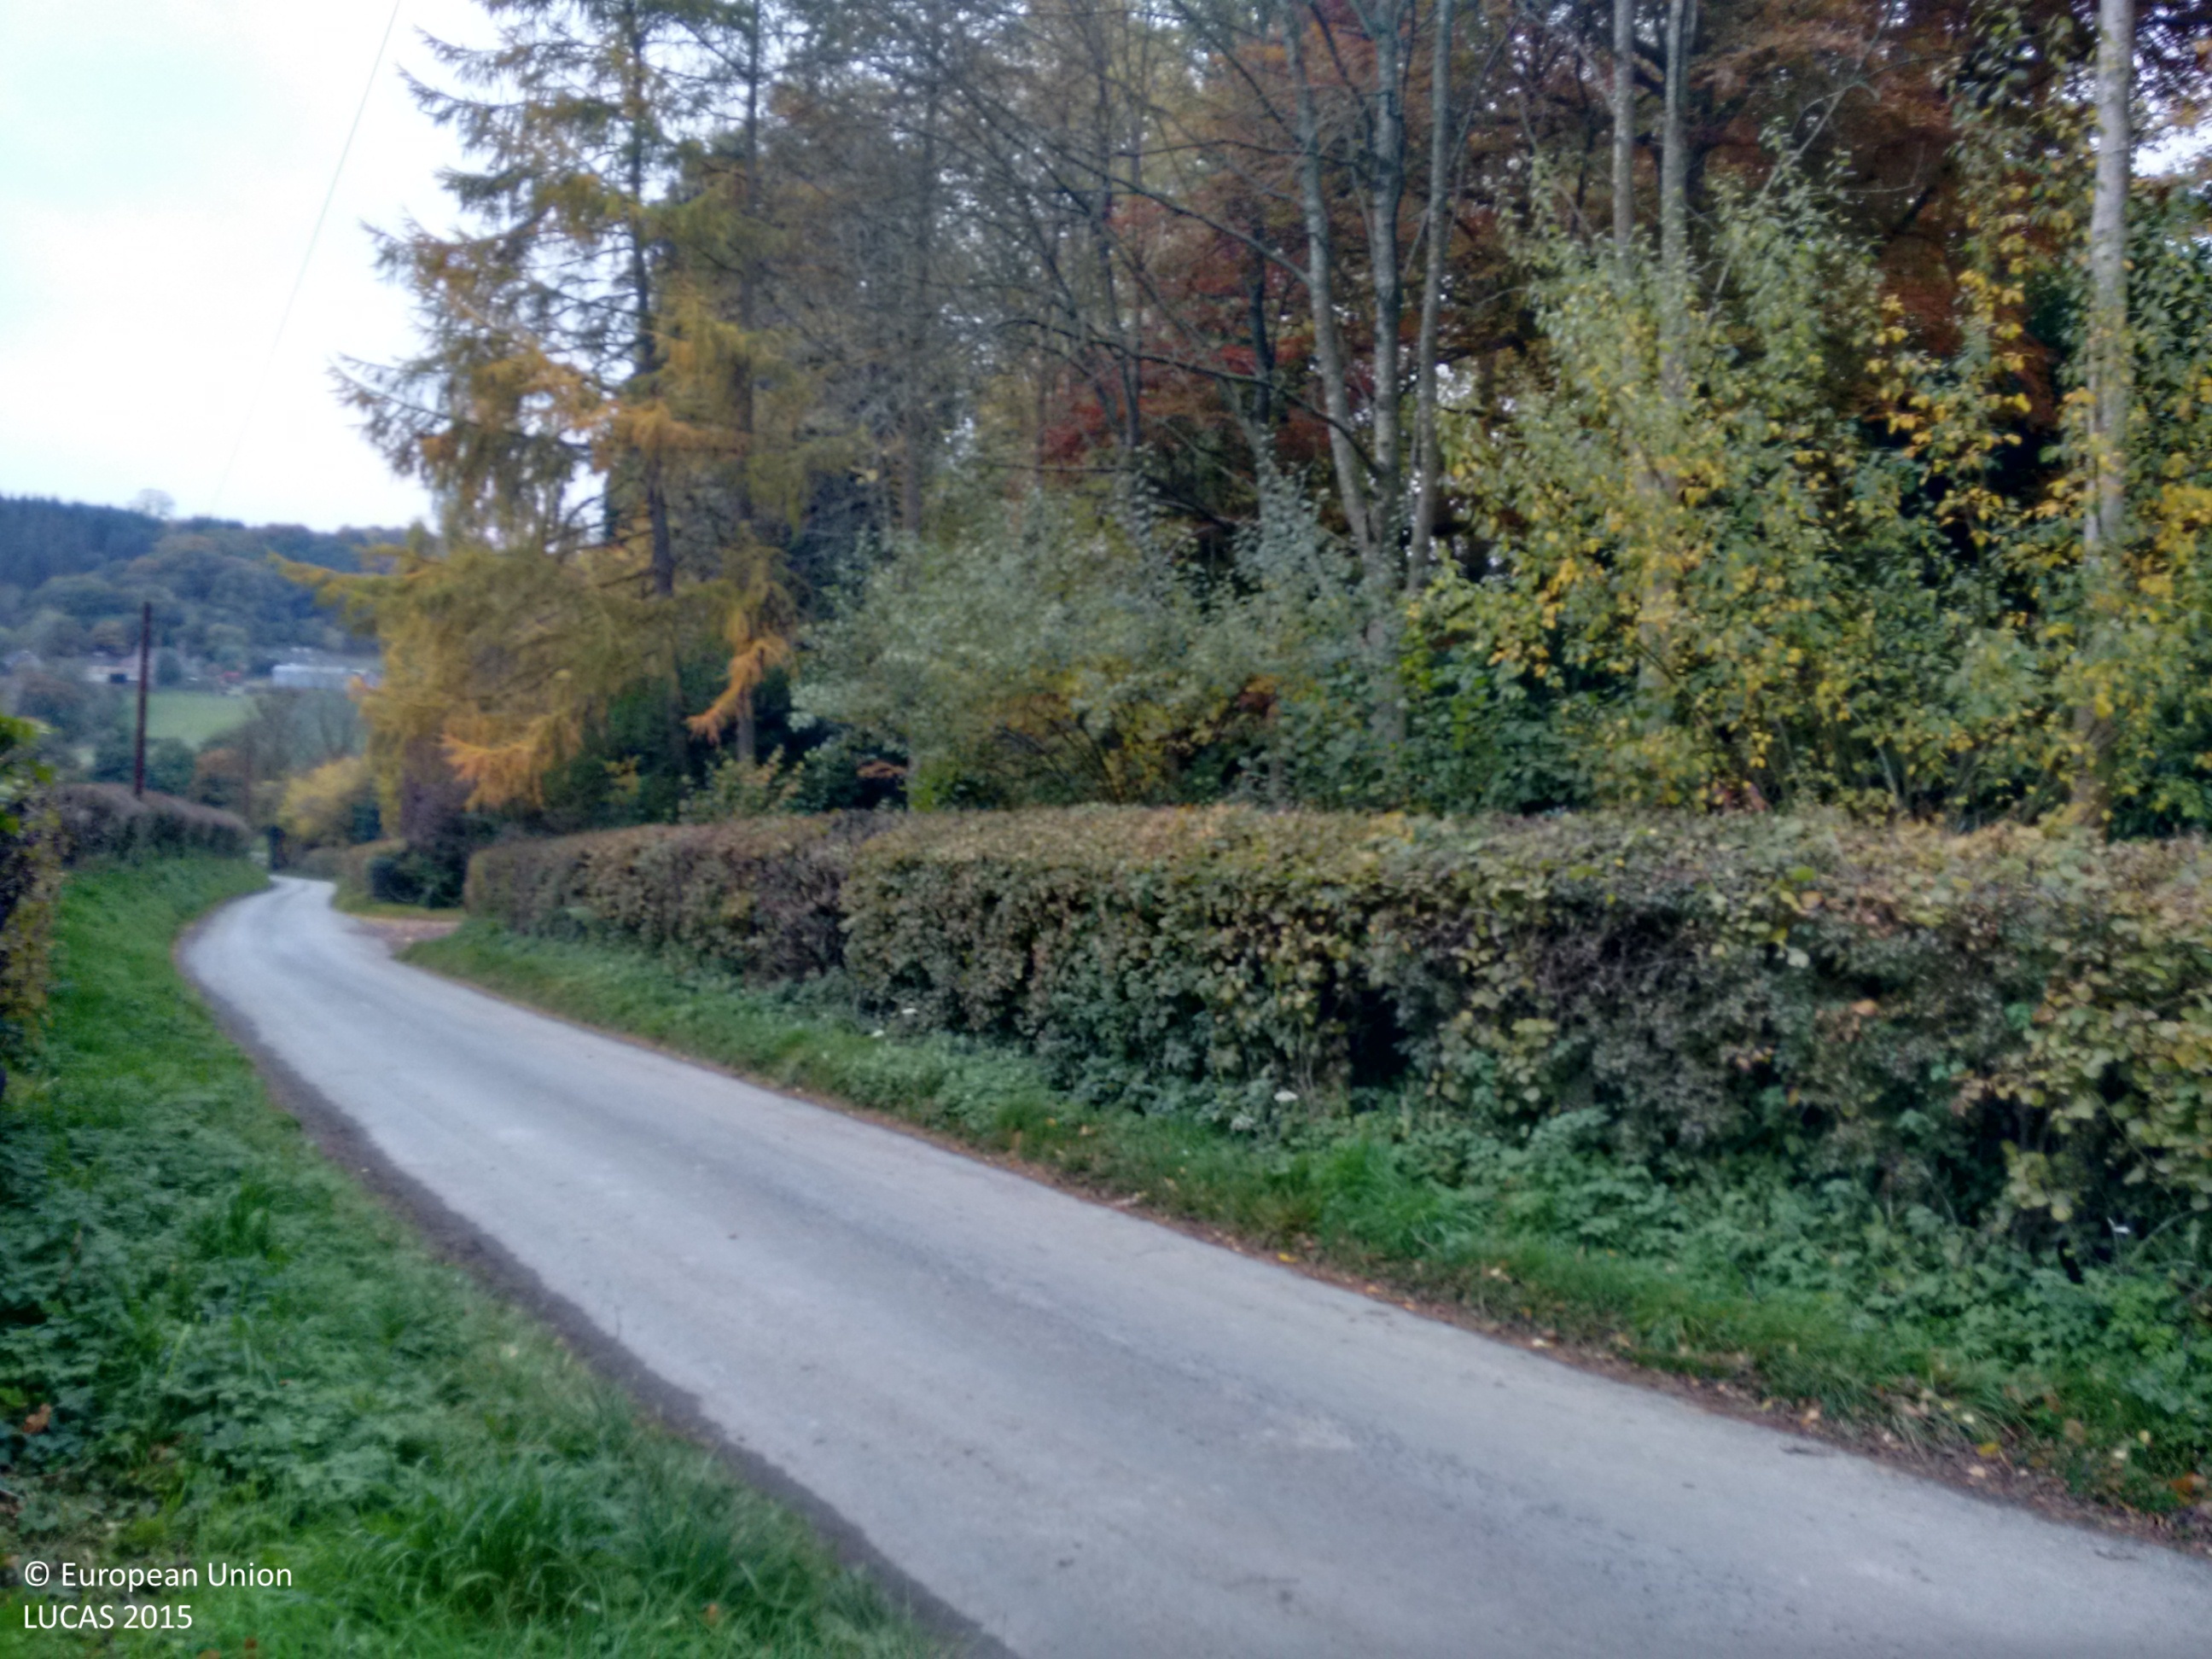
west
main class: Grassland
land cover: Grassland without tree/shrub cover
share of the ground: > 75 %
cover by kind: herbaceous plants 100 %
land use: Agriculture (excluding fallow land and kitchen gardens)
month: October
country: GB
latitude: 52.4669
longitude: -2.7741
